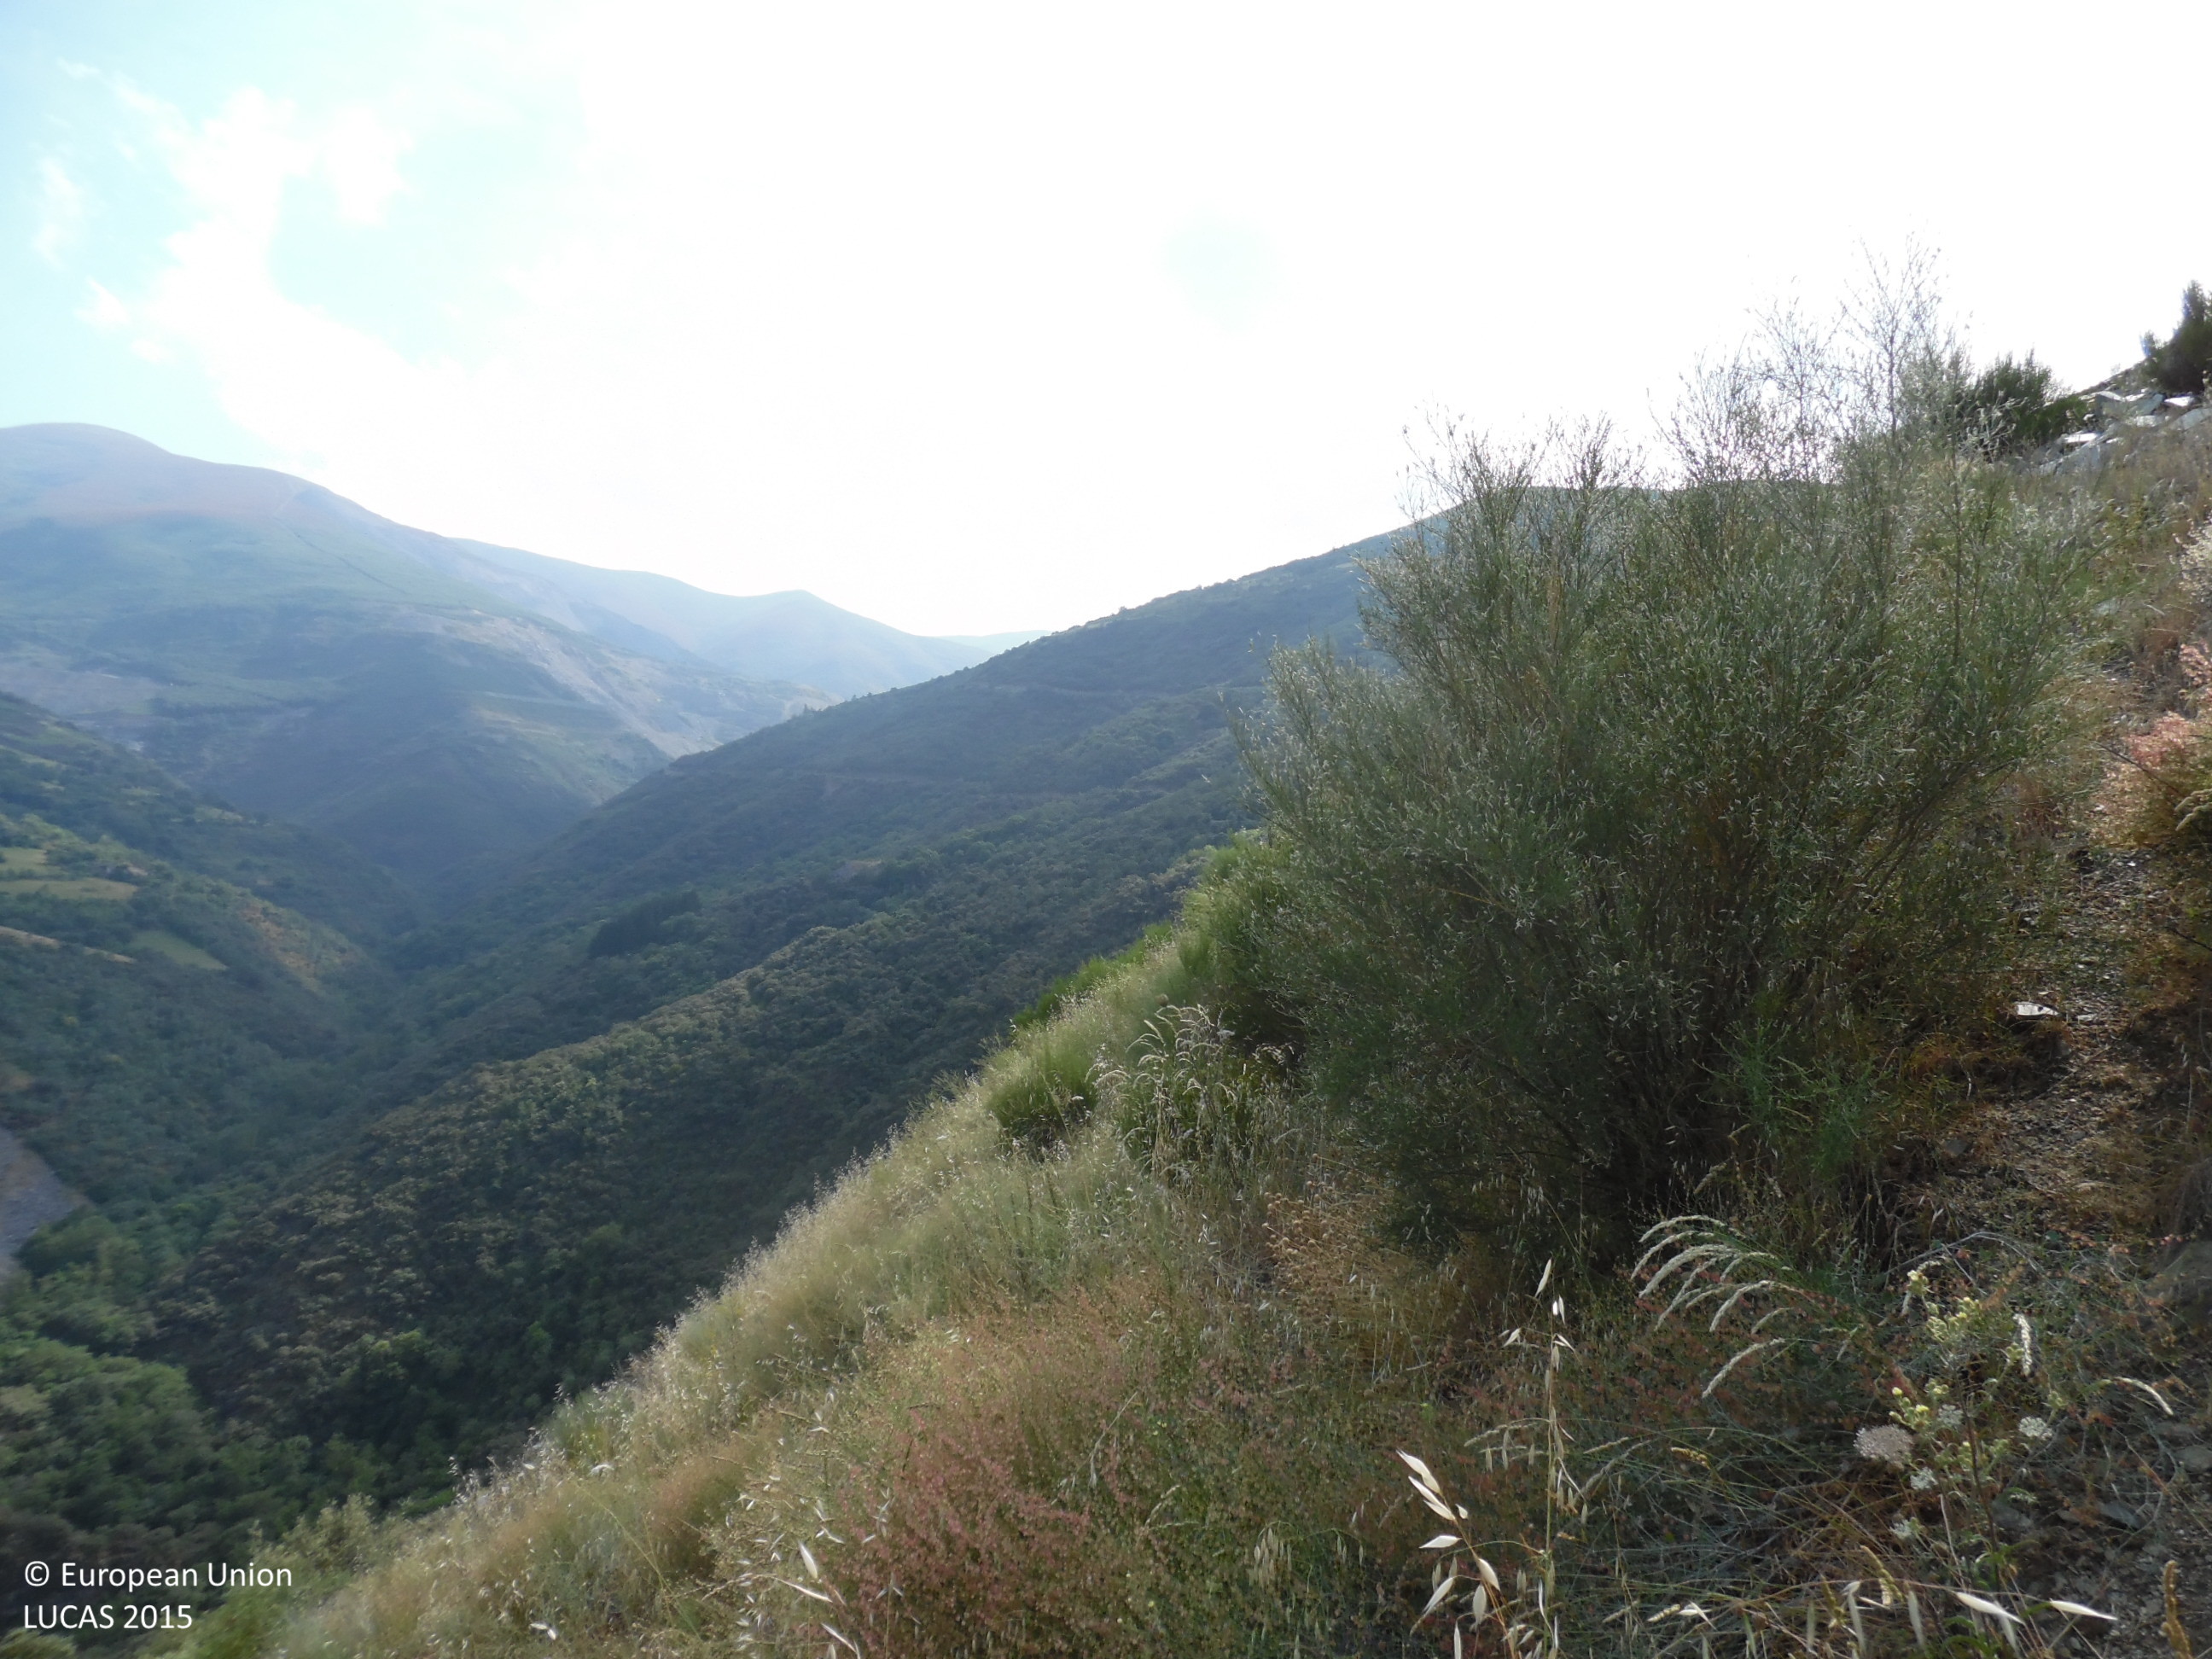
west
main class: Shrubland
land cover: Shrubland without tree cover
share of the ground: > 75 %
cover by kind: shrubs 100 %
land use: Abandoned areas
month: June
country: ES
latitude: 42.4140
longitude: -6.7078
